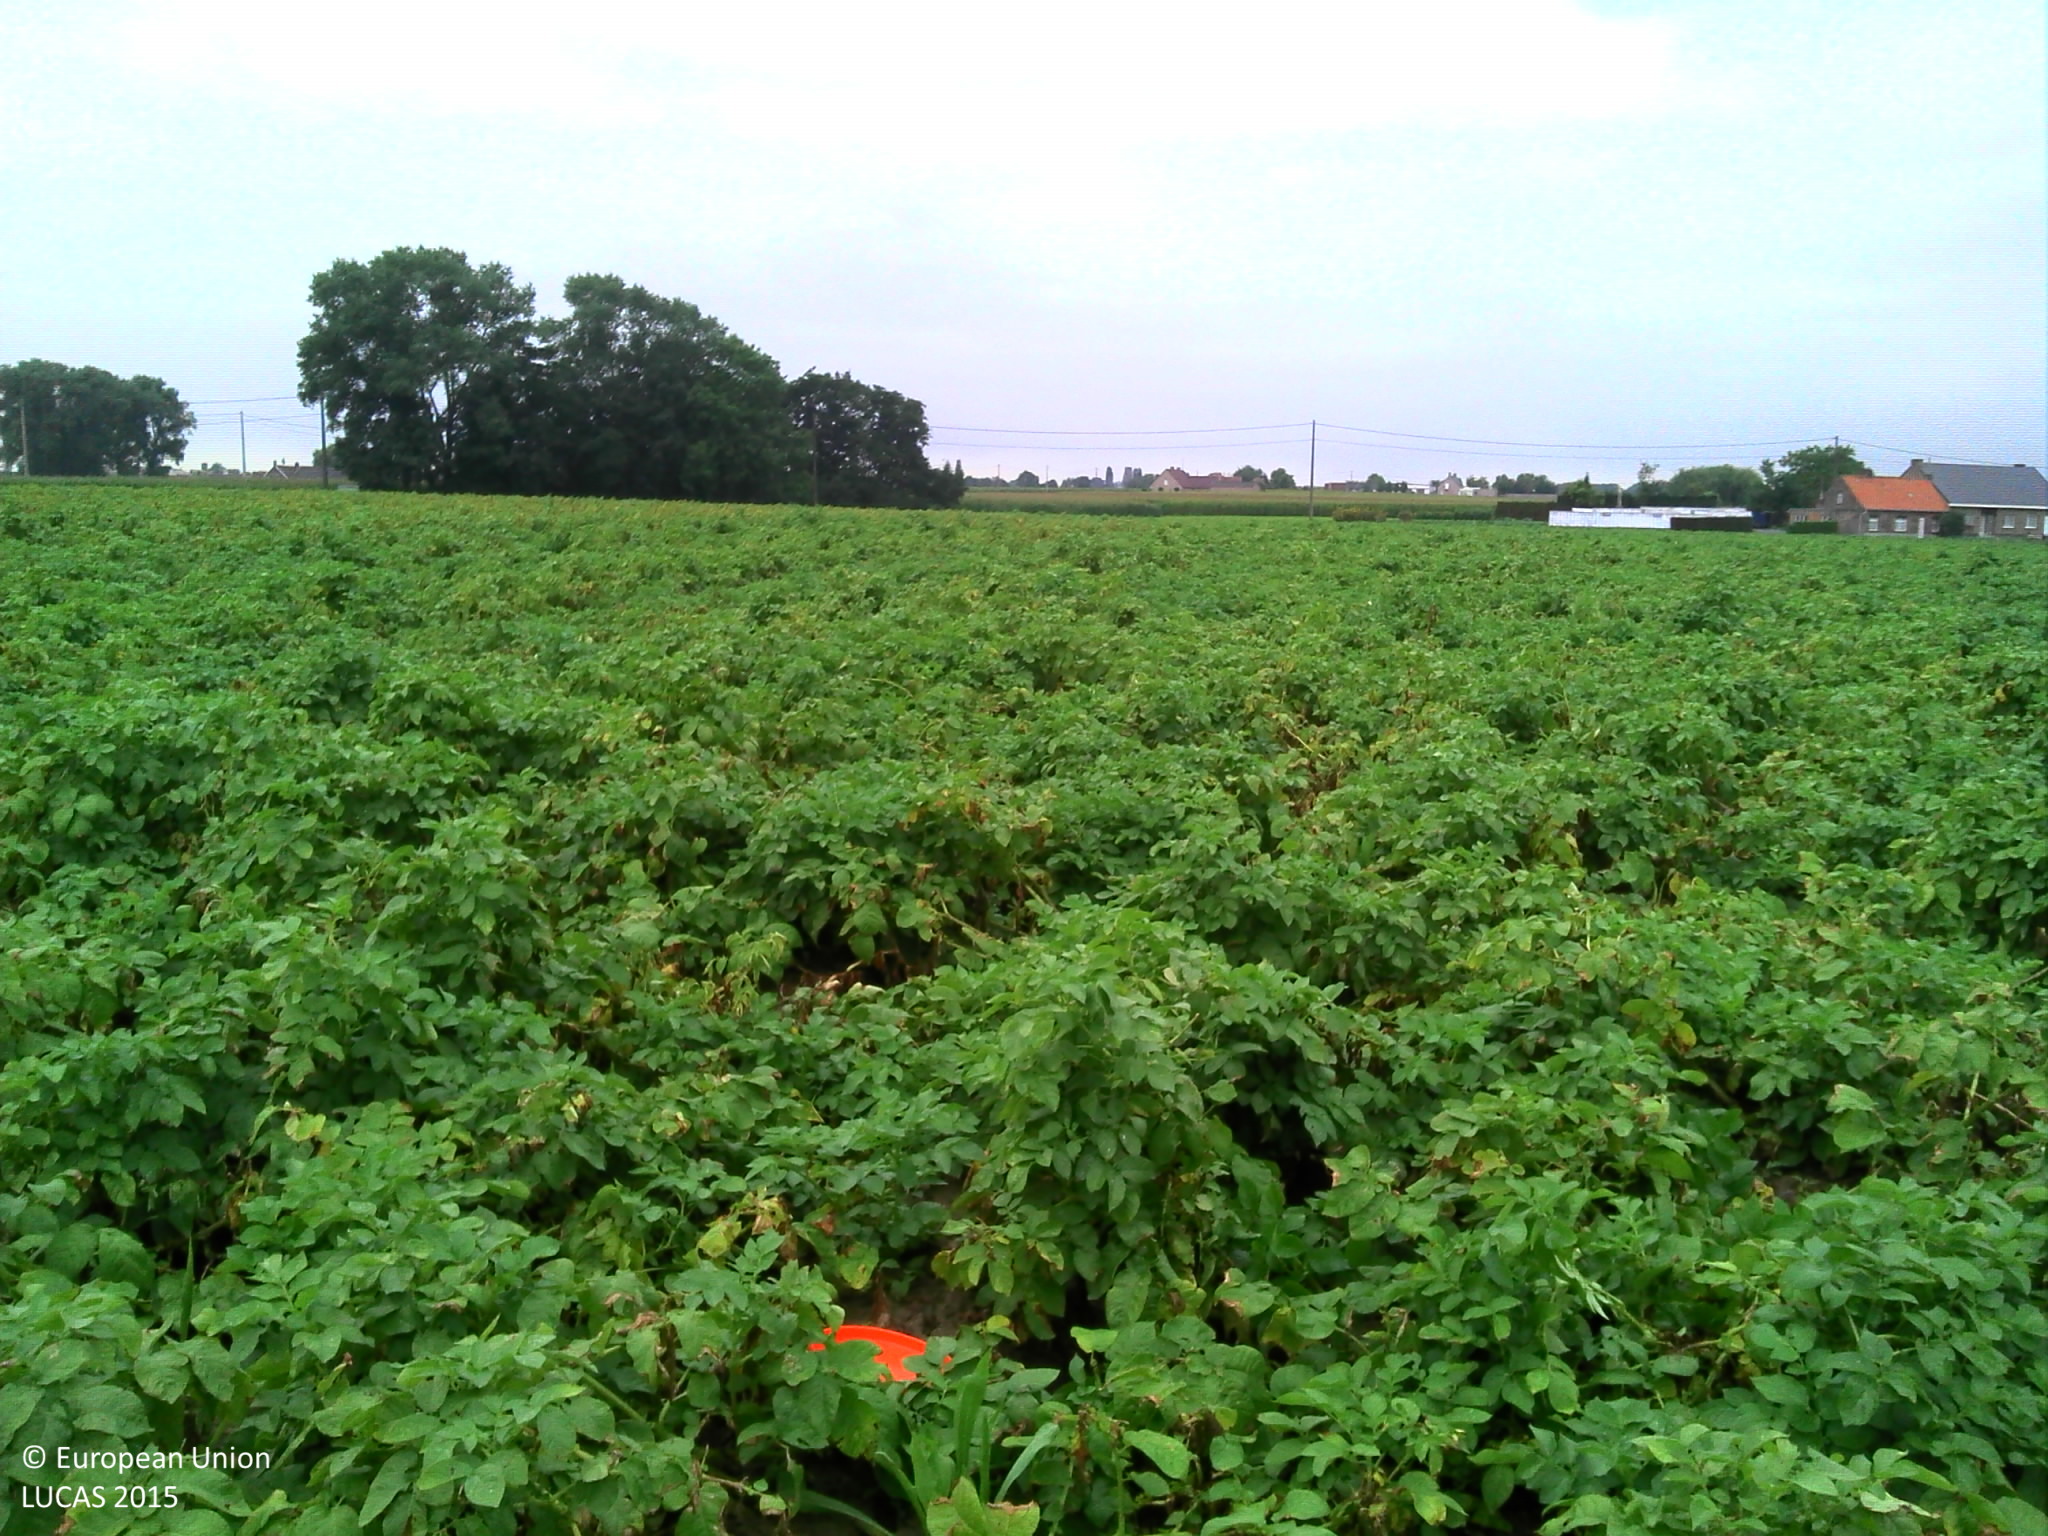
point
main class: Cropland
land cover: Potatoes
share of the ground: > 75 %
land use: Agriculture (excluding fallow land and kitchen gardens)
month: September
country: BE
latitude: 51.0062
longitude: 3.4505
